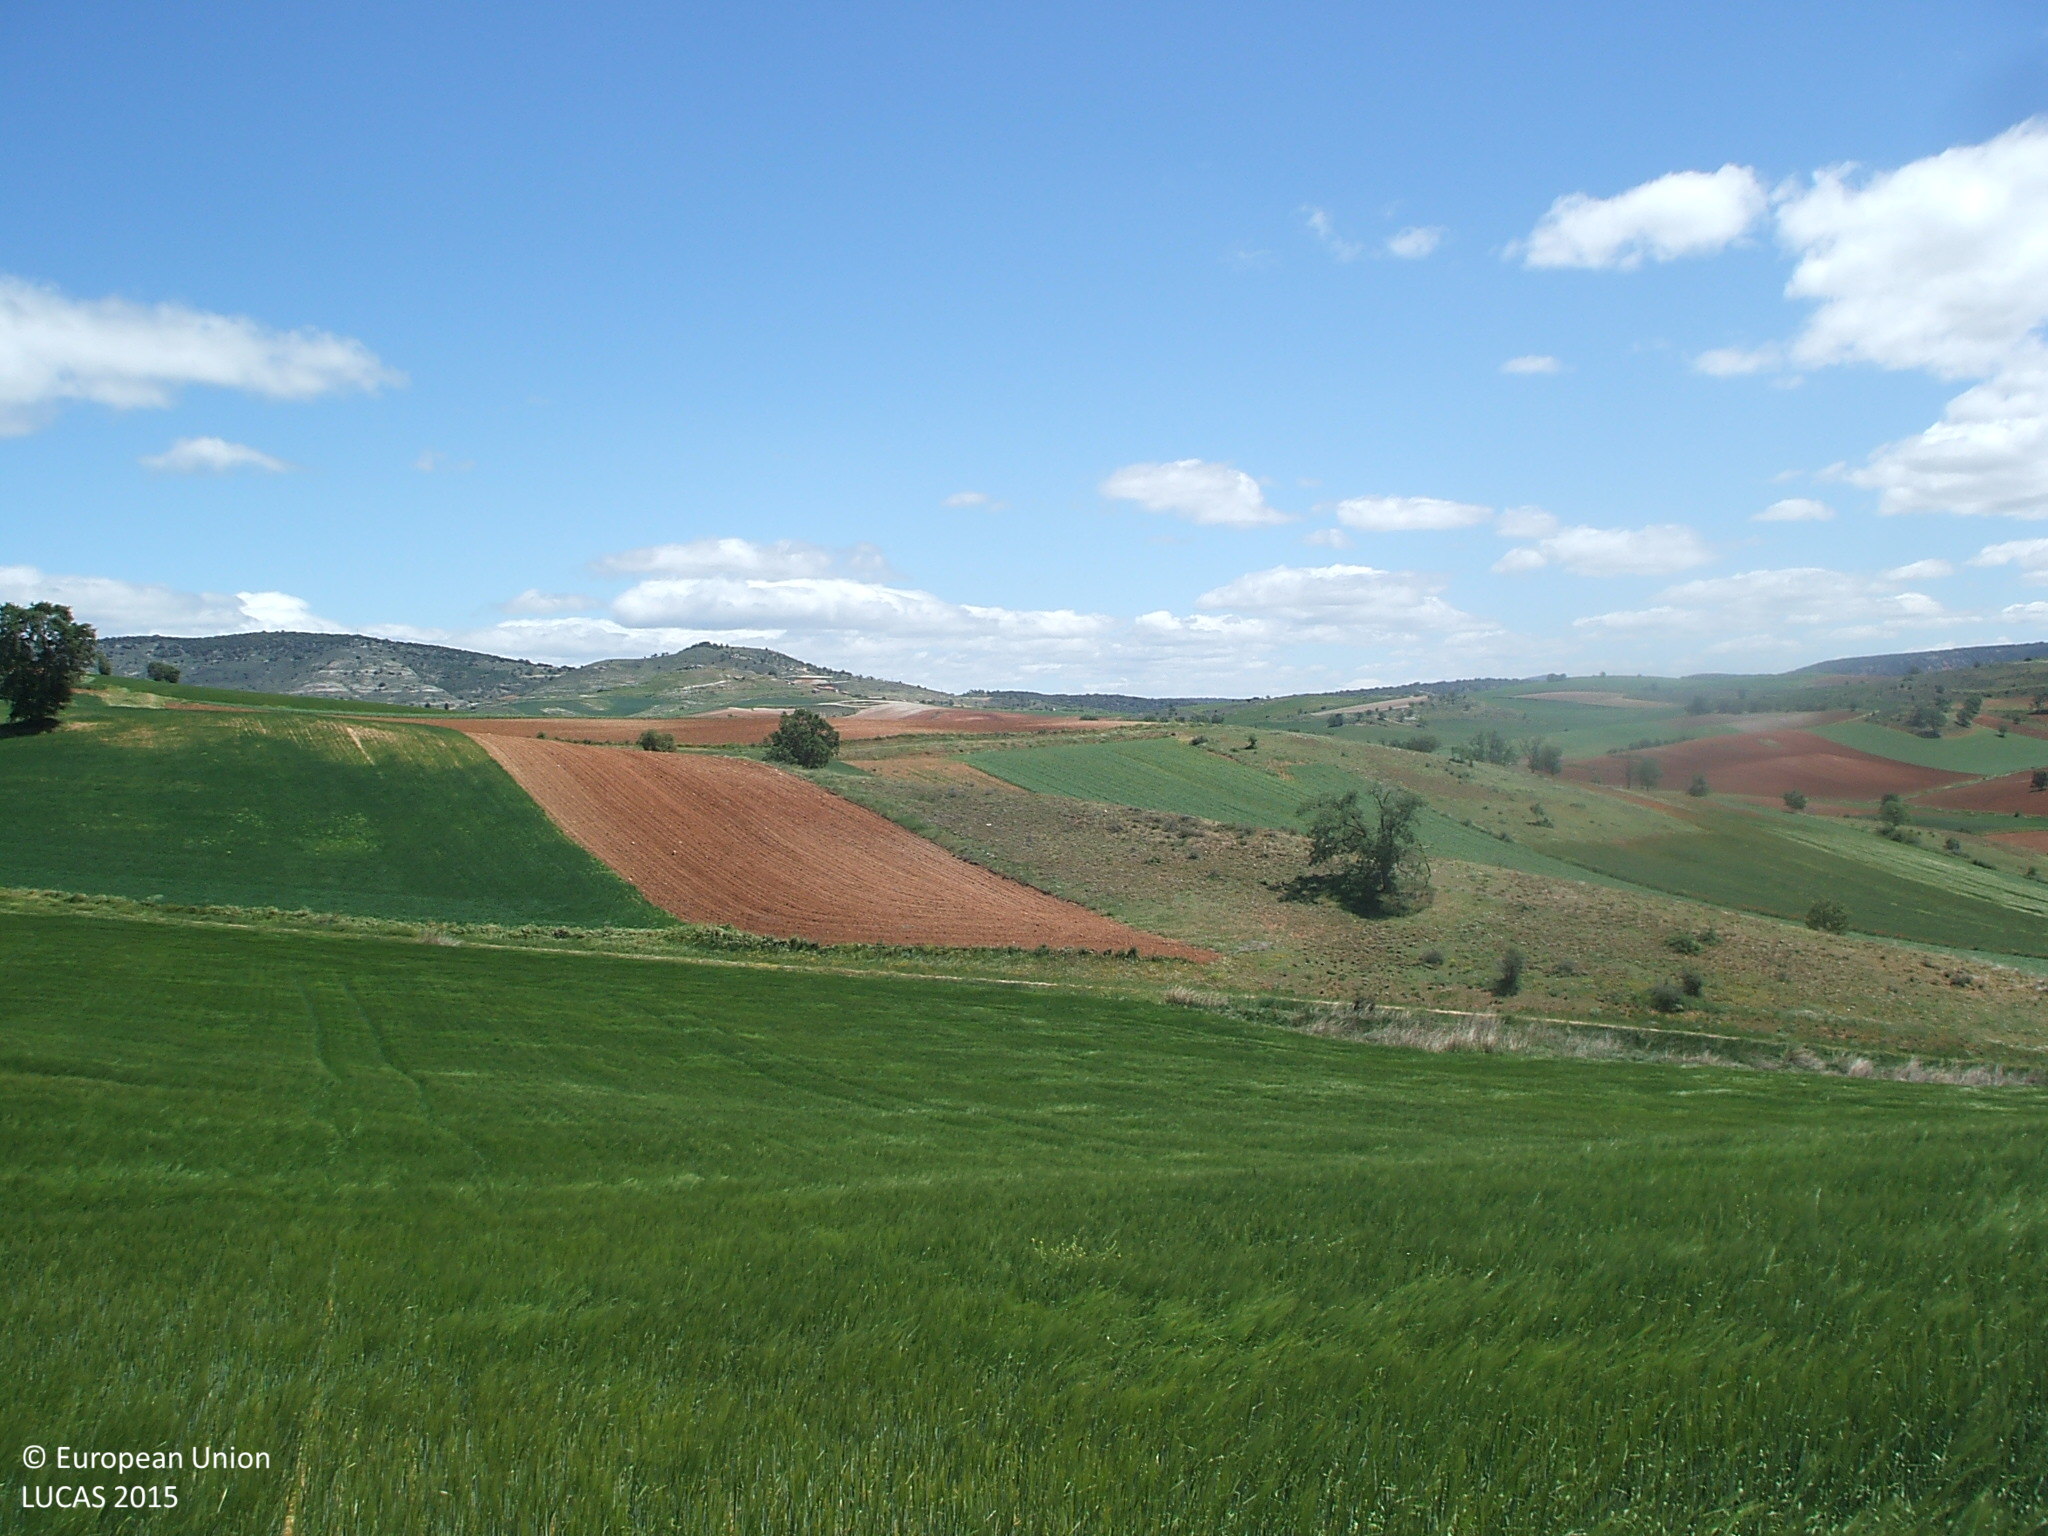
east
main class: Cropland
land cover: Barley
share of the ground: > 75 %
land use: Agriculture (excluding fallow land and kitchen gardens)
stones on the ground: 25 - 50 %
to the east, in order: Barley; Grassland without tree/shrub cover; Tracks; Grassland without tree/shrub cover; Dry pulses
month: May
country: ES
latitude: 40.9691
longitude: -2.8794
